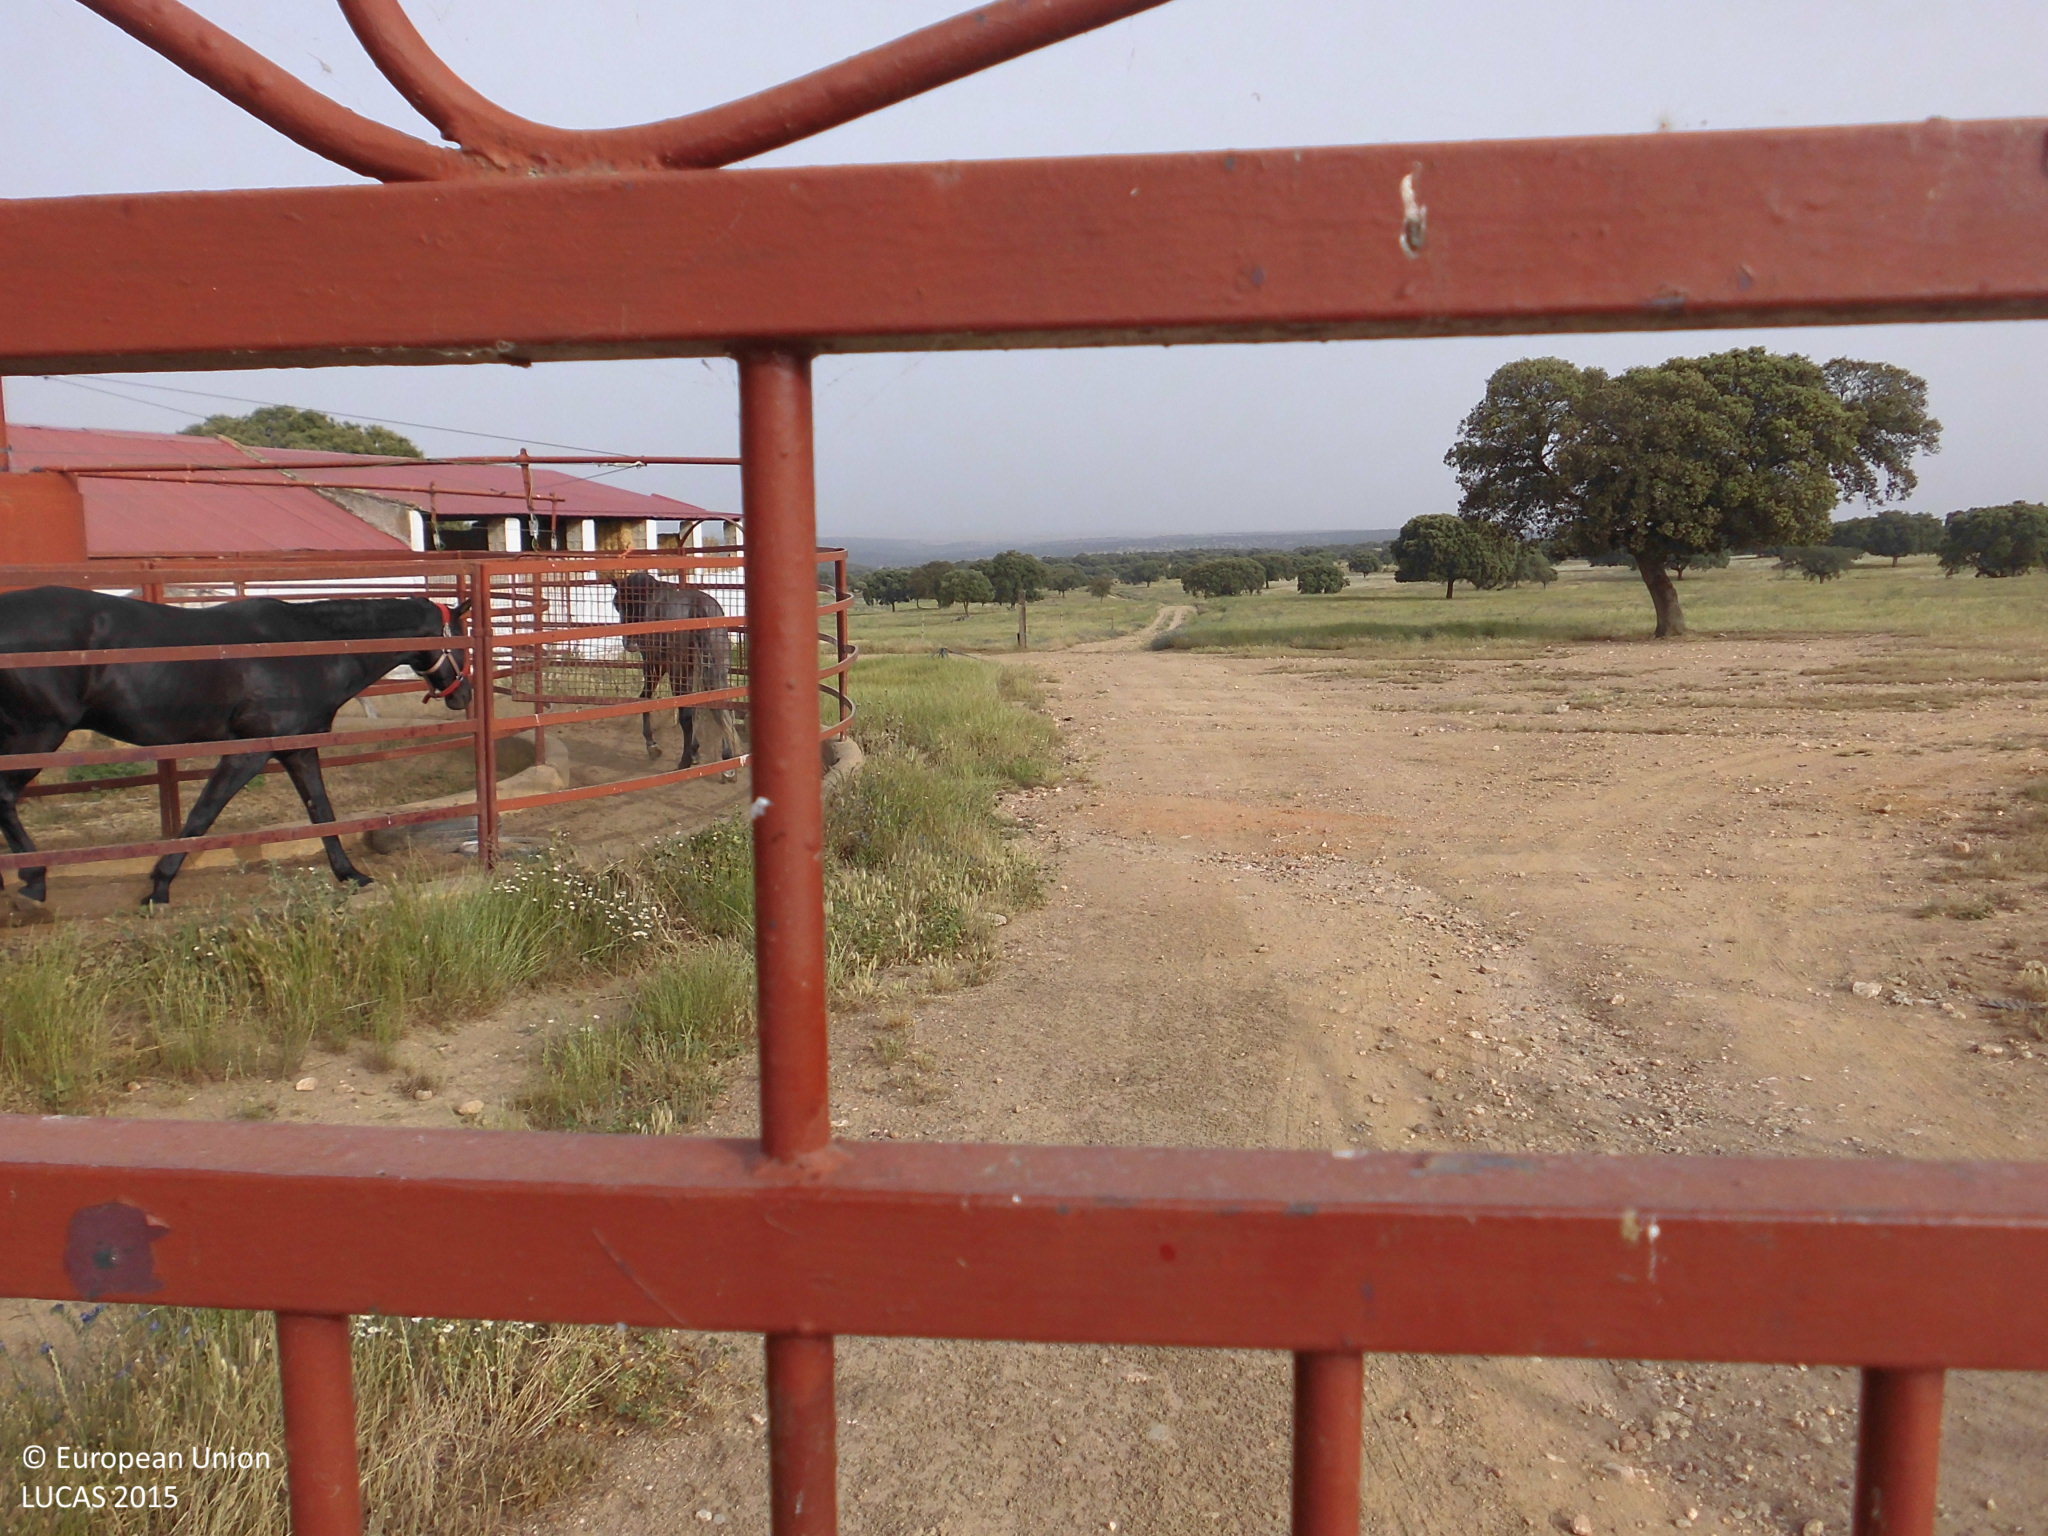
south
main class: Woodland
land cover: Broadleaved woodland
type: broadleaved evergreen forest
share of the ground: 10 - 25 %
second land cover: Grassland without tree/shrub cover
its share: > 75 %
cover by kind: shrubs 45 %, herbaceous plants 45 %, broadleaved forest trees 10 %
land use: Semi-natural and natural areas not in use
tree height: > 5 m
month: May
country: ES
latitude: 39.6046
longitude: -6.1256
